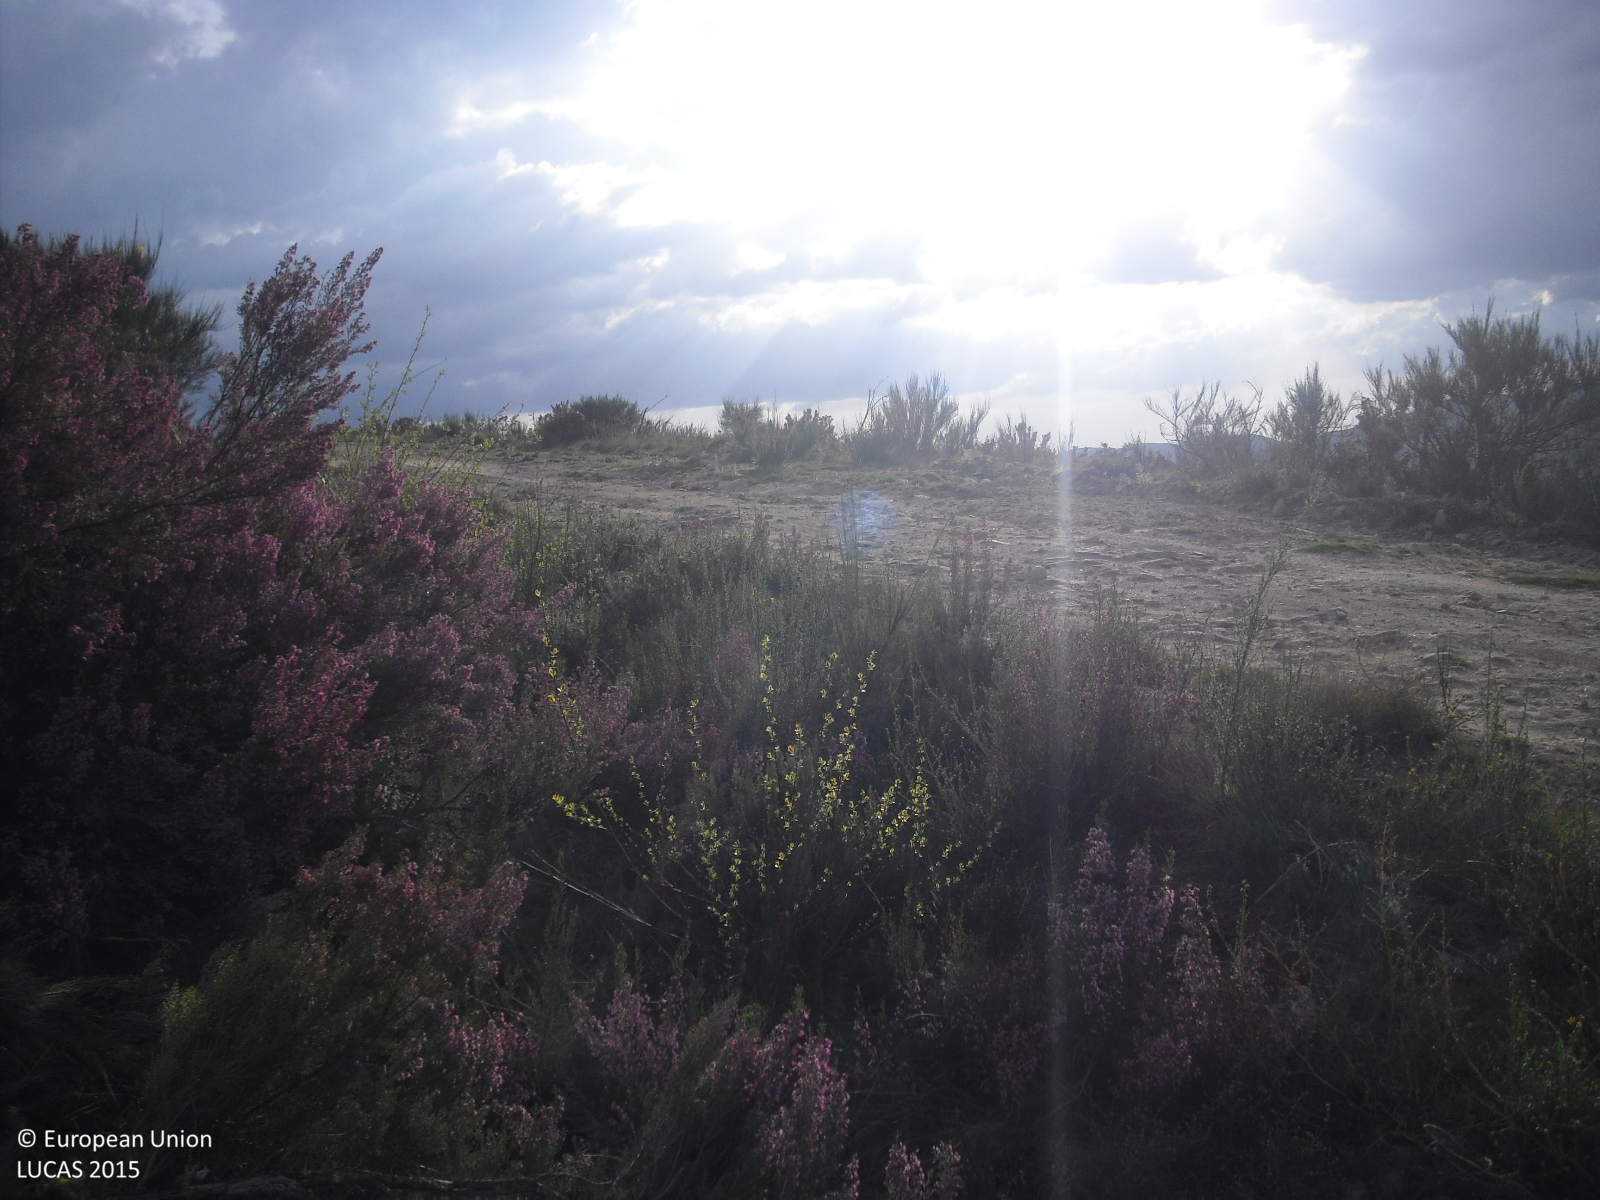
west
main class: Shrubland
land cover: Shrubland without tree cover
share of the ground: > 75 %
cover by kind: shrubs 90 %, herbaceous plants 5 %, unconsolidated bare surface 5 %
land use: Semi-natural and natural areas not in use
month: April
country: ES
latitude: 41.9272
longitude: -7.7095
